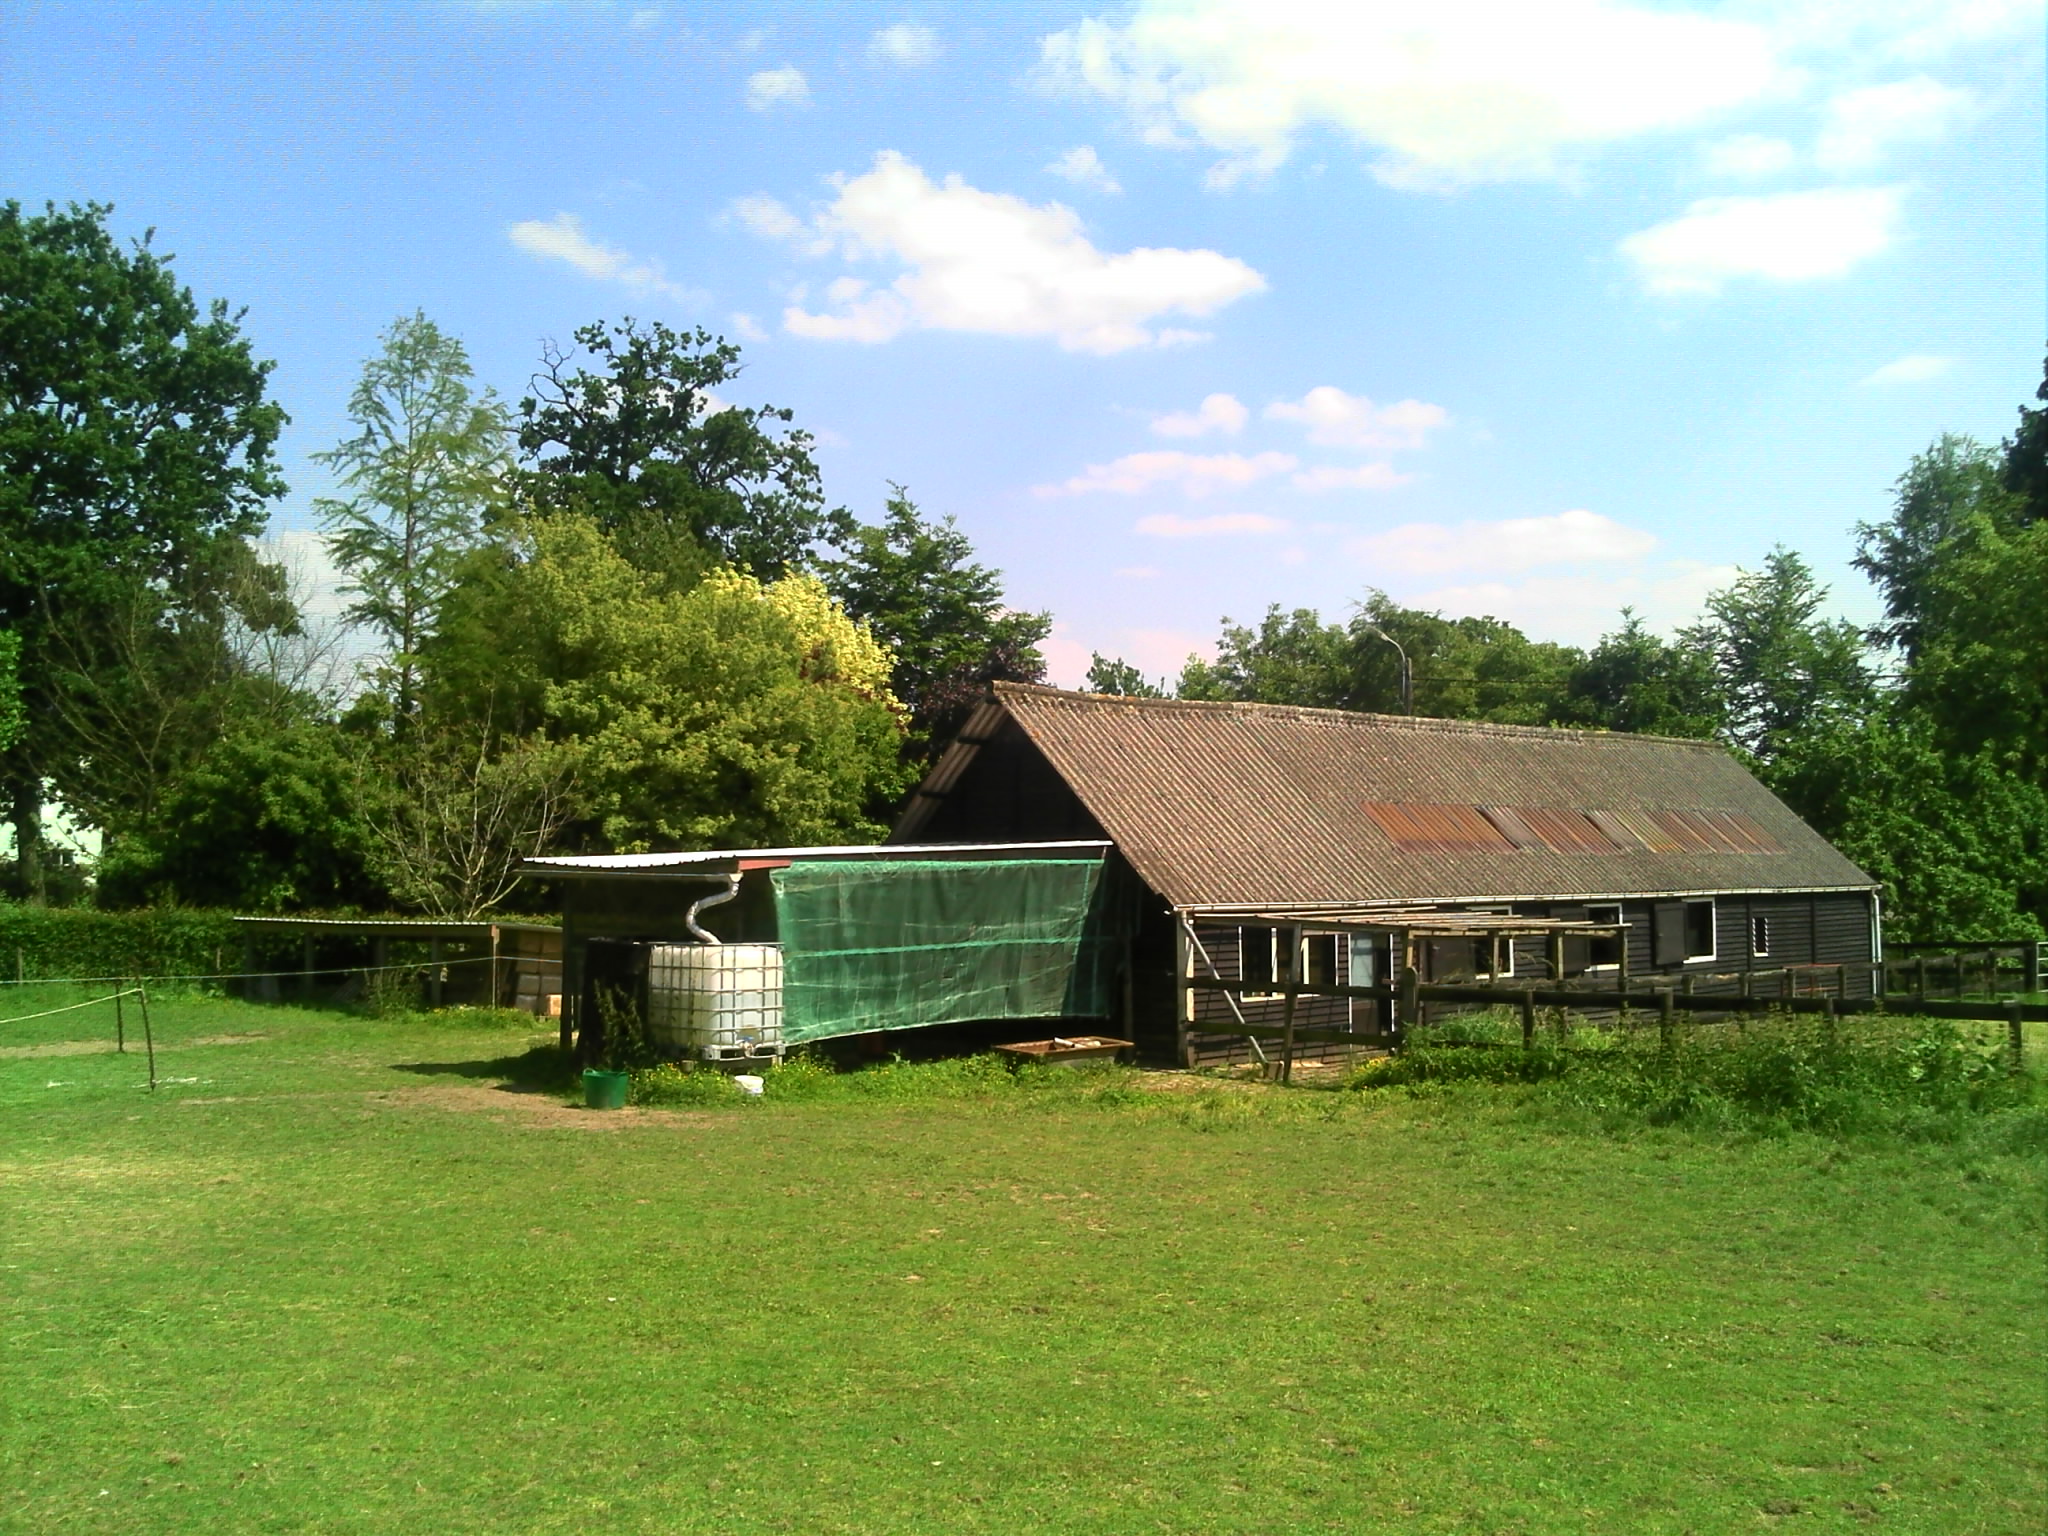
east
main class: Grassland
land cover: Grassland without tree/shrub cover
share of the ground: > 75 %
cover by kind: herbaceous plants 100 %
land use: Agriculture (excluding fallow land and kitchen gardens)
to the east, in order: Grassland without tree/shrub cover; Fences; Tracks; Broadleaved woodland; Artificial constructions in urban areas; Grassland with sparse tree/shrub cover; Artificial constructions in urban areas; Tracks; Maize
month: June
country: BE
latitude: 50.9245
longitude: 4.2903
